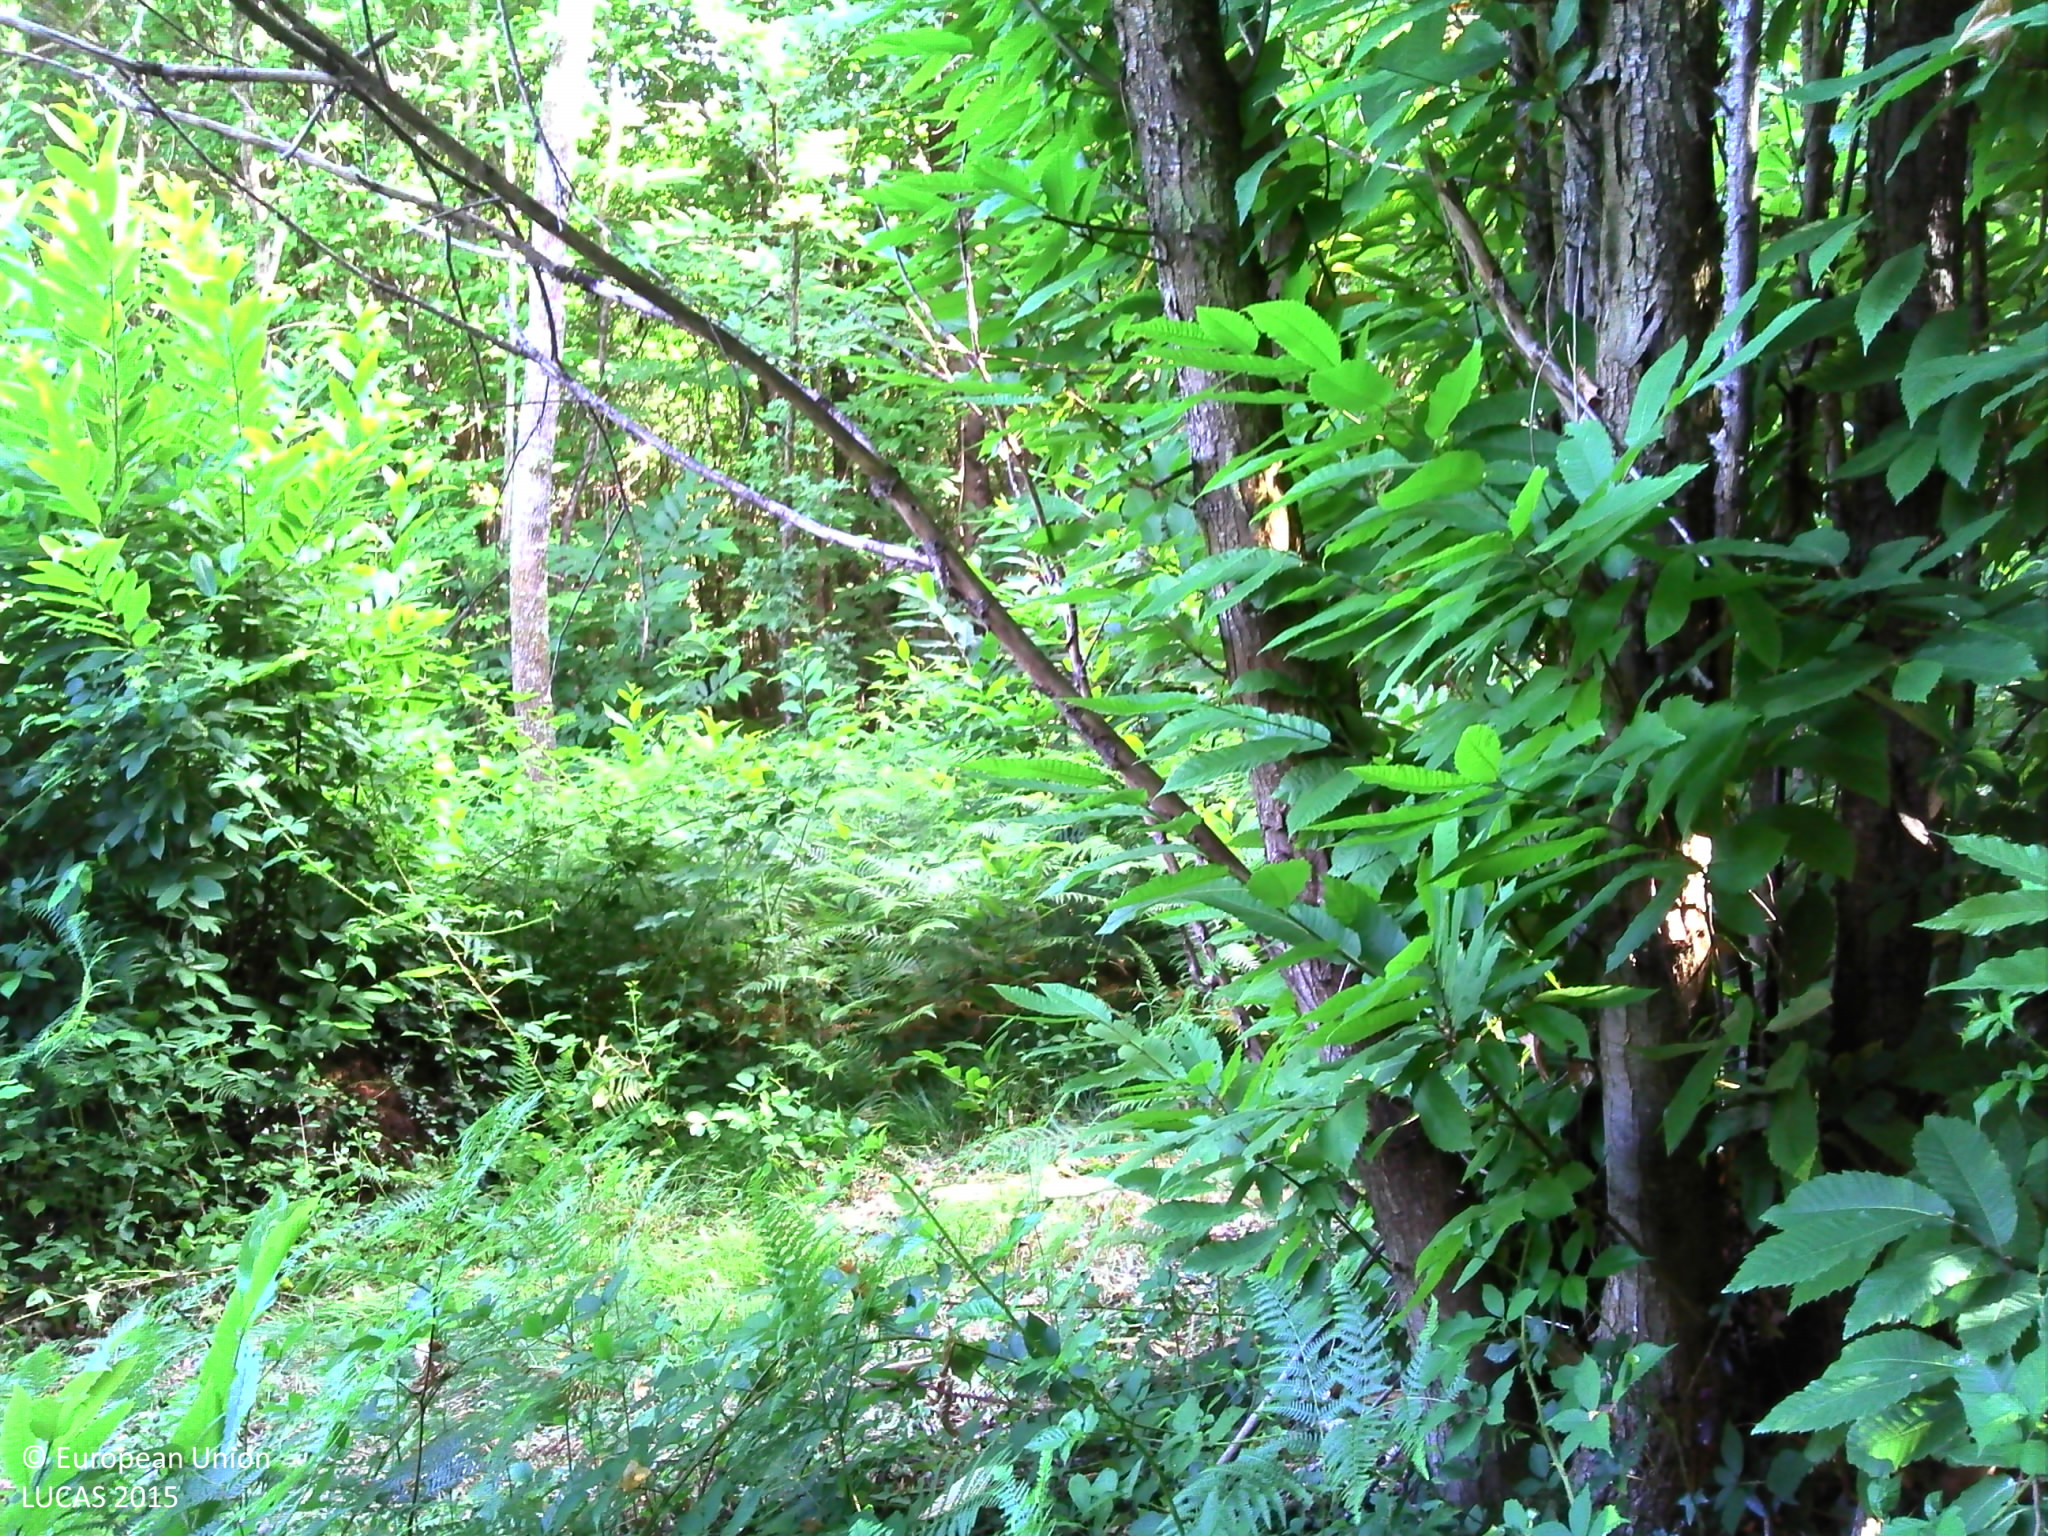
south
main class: Woodland
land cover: Broadleaved woodland
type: boreal forest
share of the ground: > 75 %
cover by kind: broadleaved forest trees 70 %, shrubs 20 %, herbaceous plants 5 %, lichens and mosses 5 %
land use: Forestry
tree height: > 5 m
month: June
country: FR
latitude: 45.7203
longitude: 0.4137
